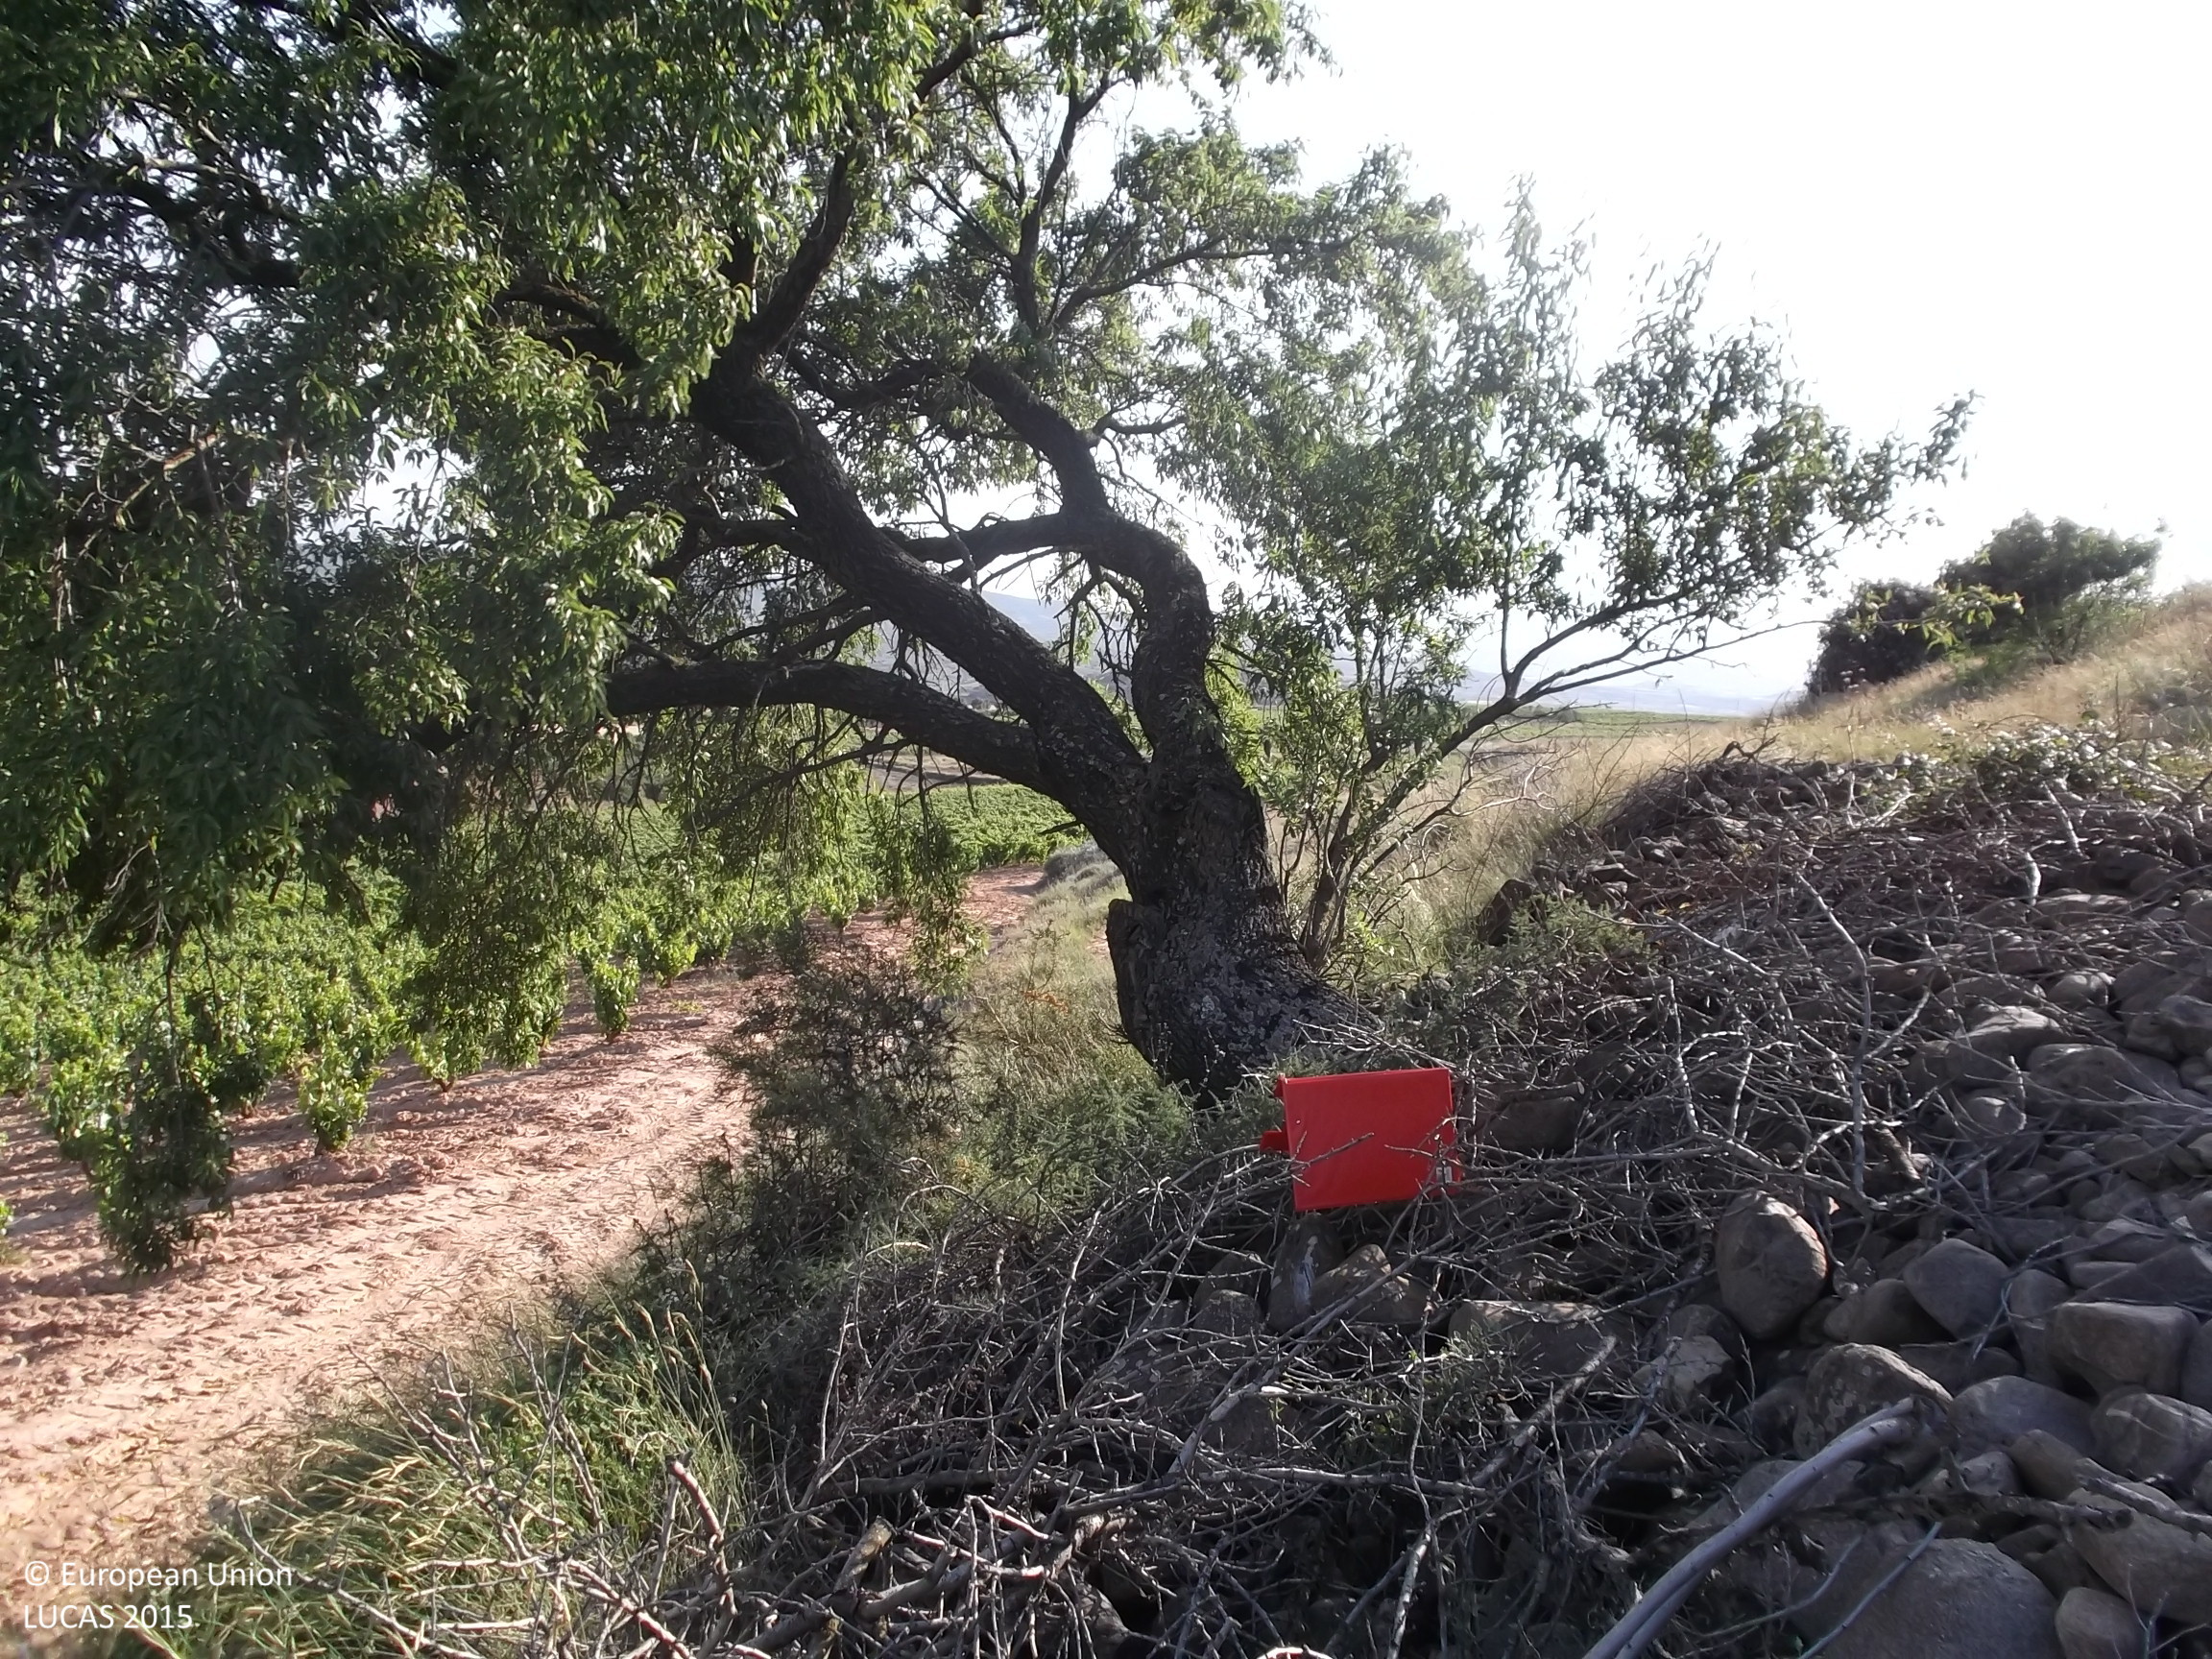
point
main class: Grassland
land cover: Grassland with sparse tree/shrub cover
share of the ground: 50 - 75 %
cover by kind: herbaceous plants 70 %, unconsolidated bare surface 25 %, broadleaved forest trees 5 %
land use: Semi-natural and natural areas not in use
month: June
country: ES
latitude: 42.3581
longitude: -2.1450
